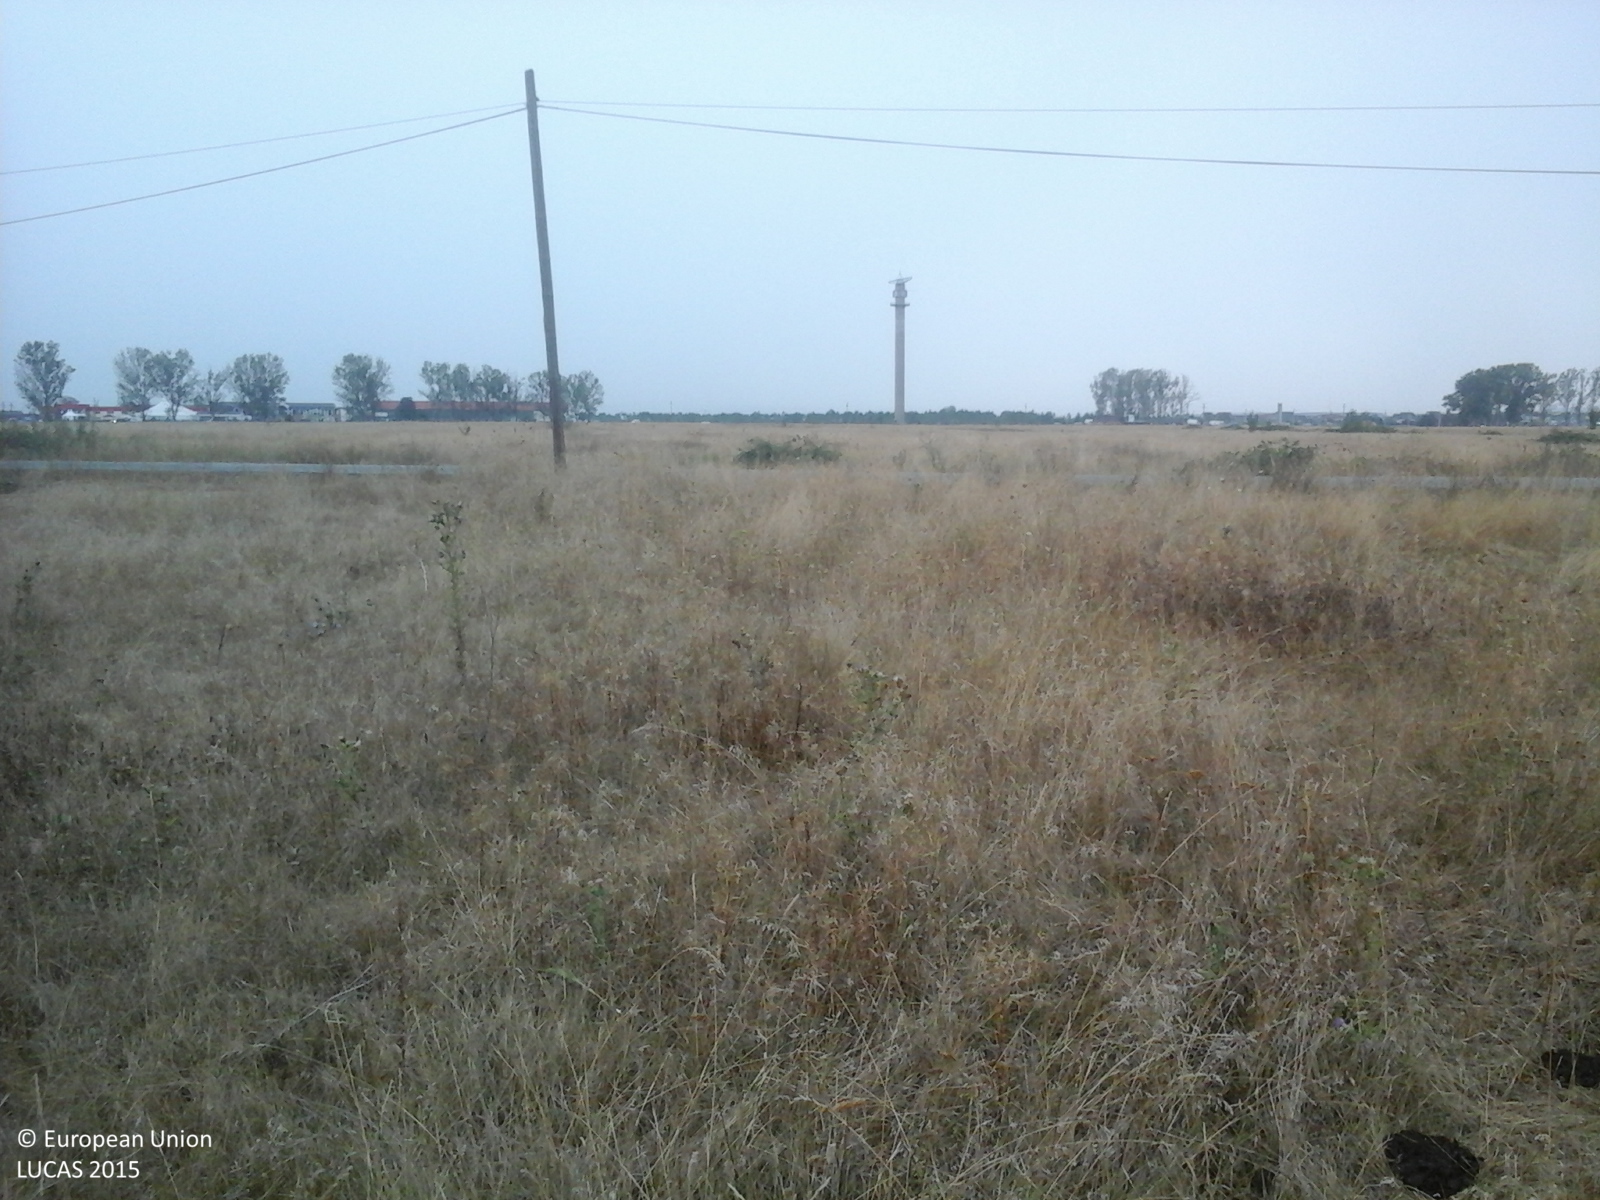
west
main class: Grassland
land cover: Spontaneously vegetated surfaces
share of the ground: > 75 %
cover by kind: herbaceous plants 100 %
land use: Agriculture (excluding fallow land and kitchen gardens)
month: September
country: RO
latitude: 47.6398
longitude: 23.5321
